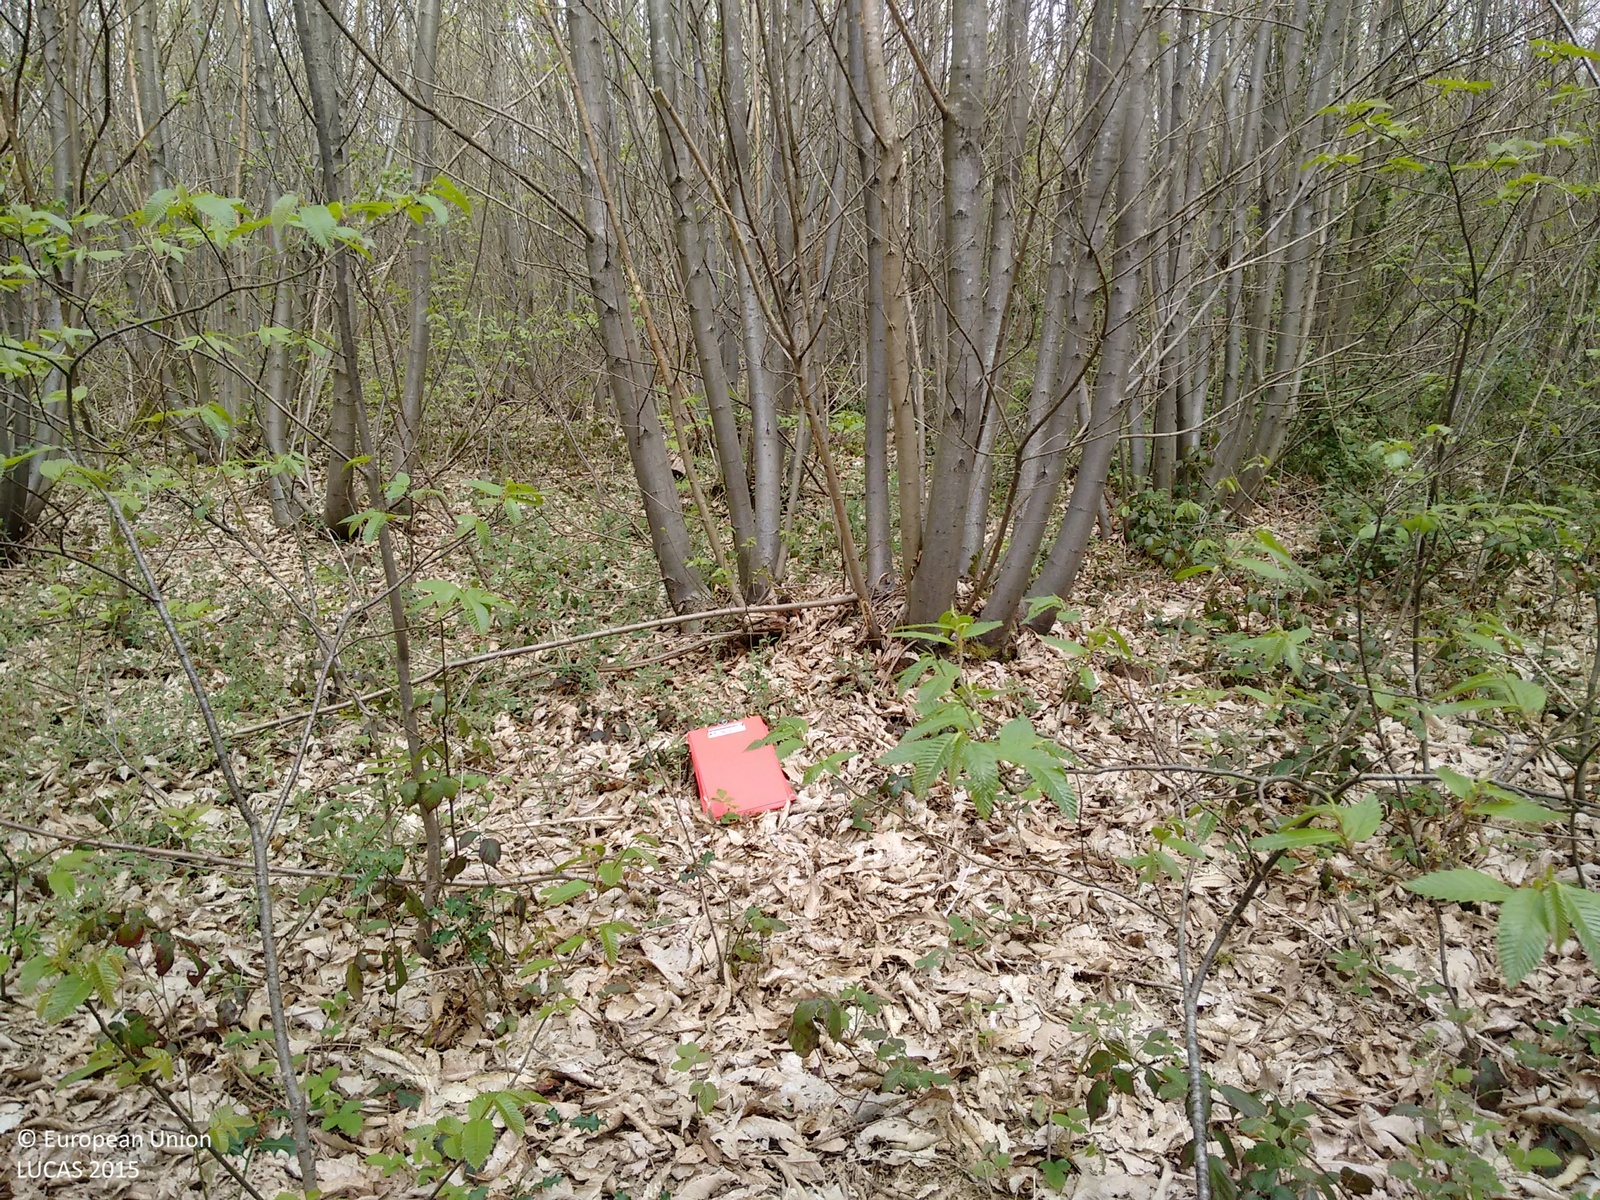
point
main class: Woodland
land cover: Broadleaved woodland
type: mesophytic deciduous forest
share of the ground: > 75 %
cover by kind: broadleaved forest trees 100 %
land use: Forestry
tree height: > 5 m
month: May
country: GB
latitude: 51.2272
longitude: 0.6224
